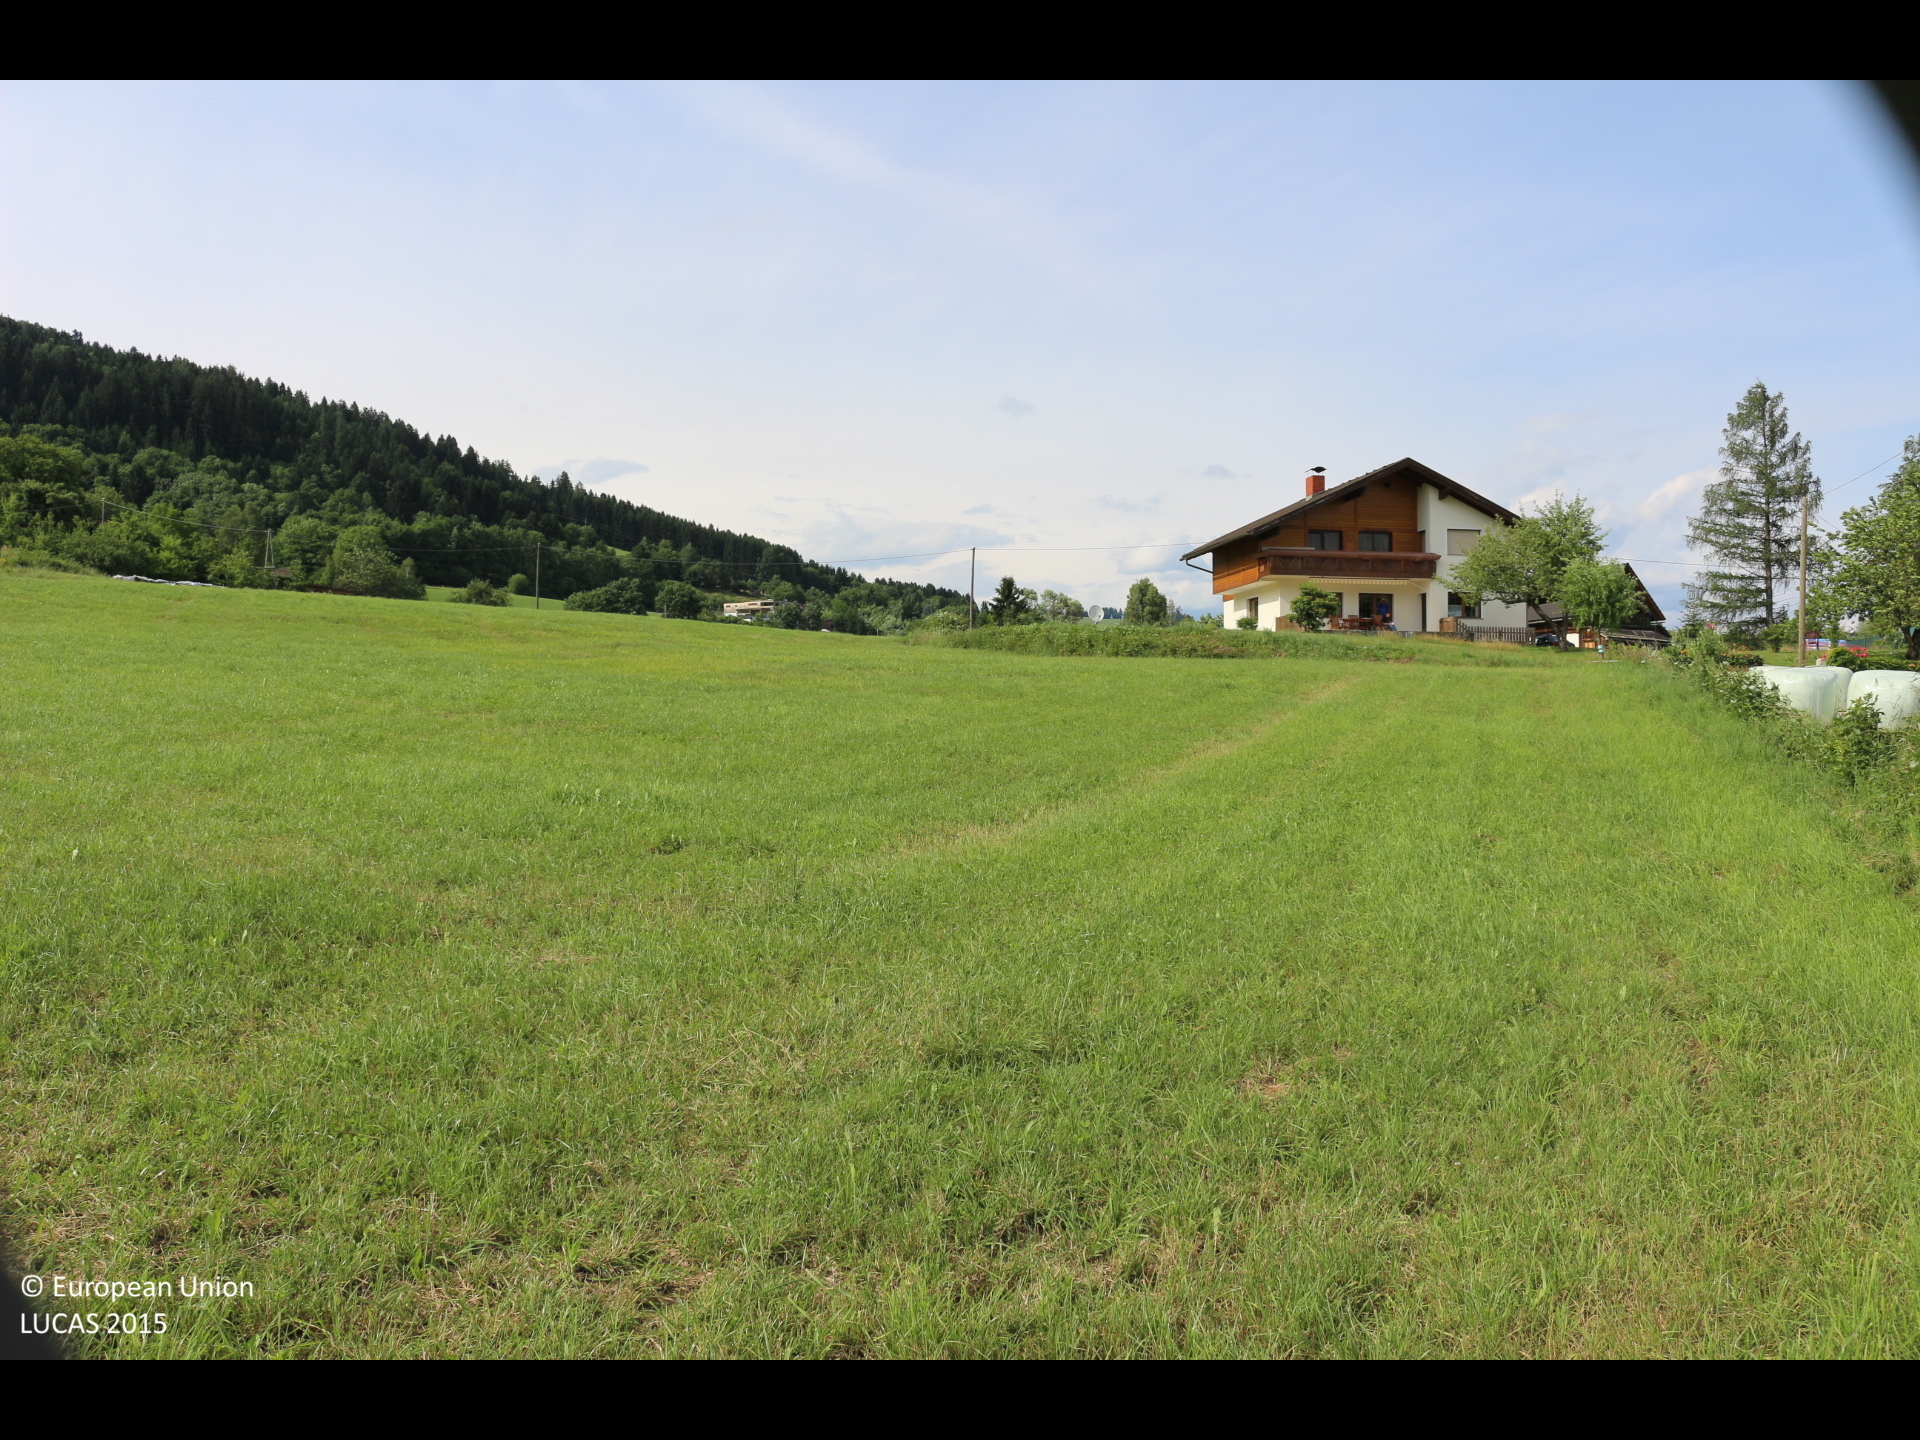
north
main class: Grassland
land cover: Grassland without tree/shrub cover
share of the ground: > 75 %
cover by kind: herbaceous plants 100 %
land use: Agriculture (excluding fallow land and kitchen gardens)
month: June
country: AT
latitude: 46.7257
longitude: 14.0406
